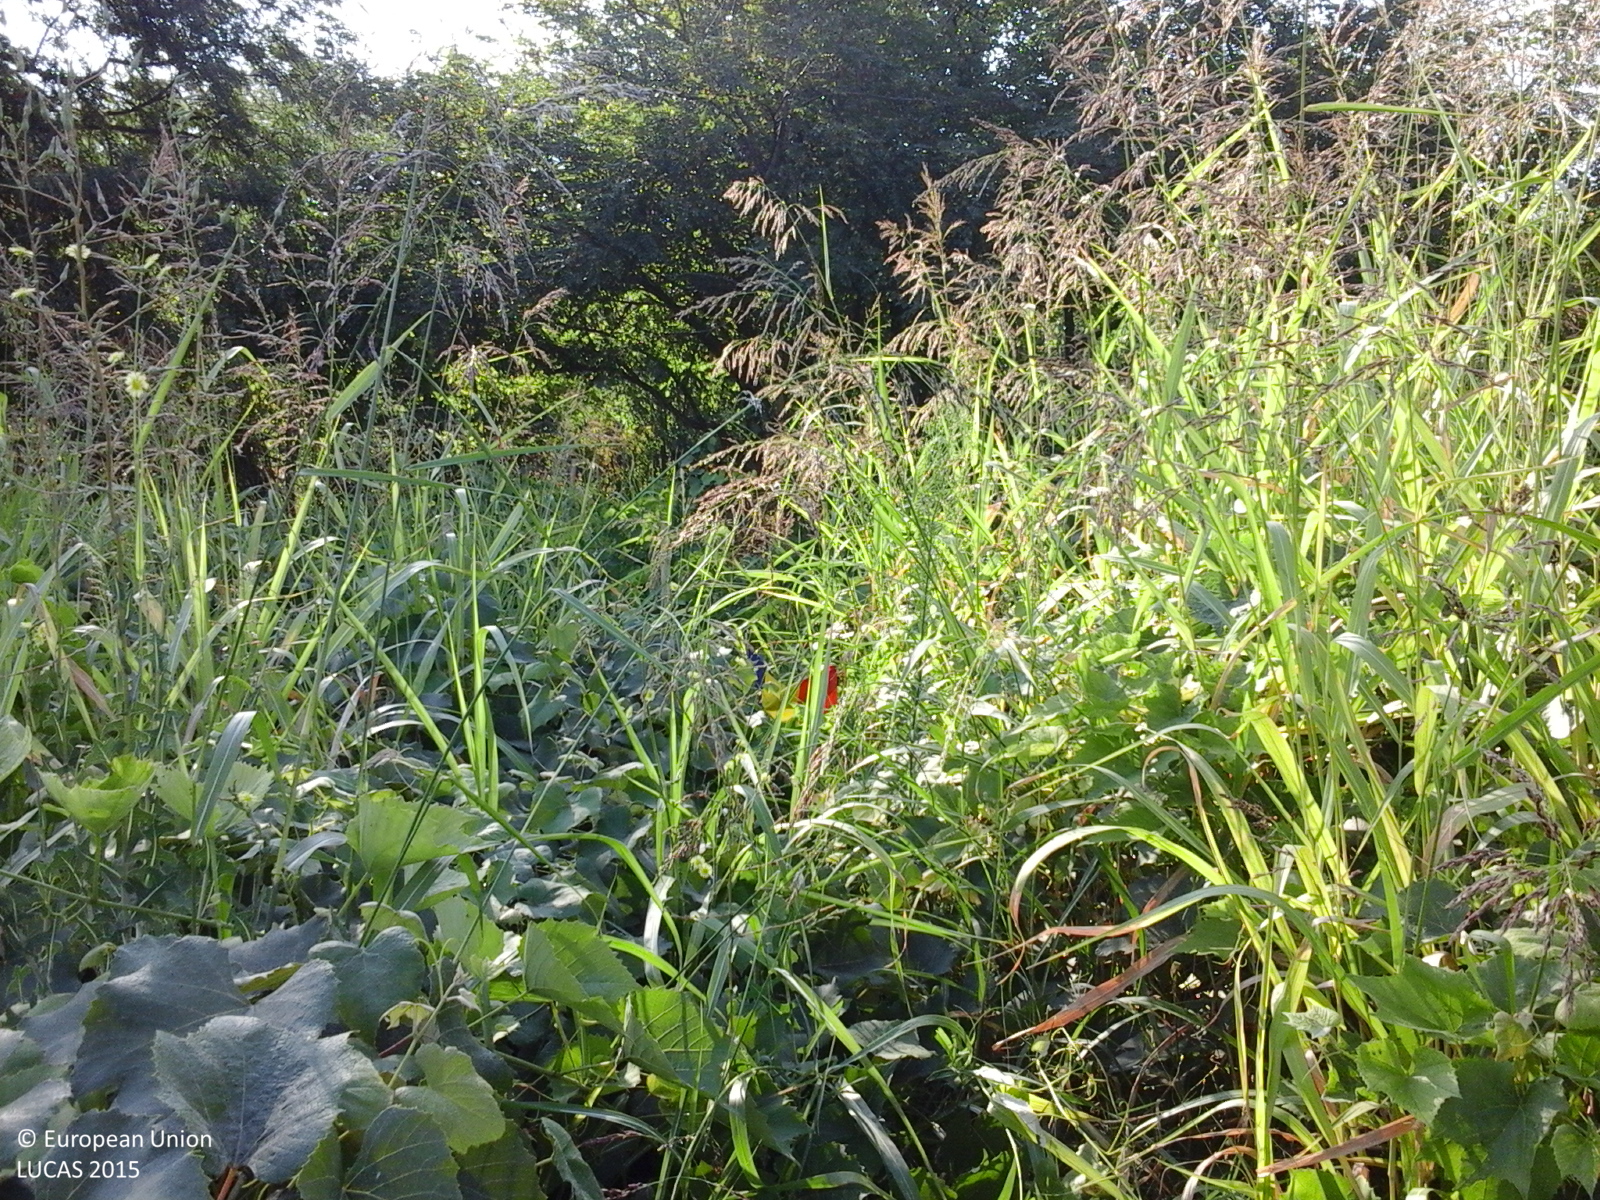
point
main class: Cropland
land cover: Vineyards
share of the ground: 50 - 75 %
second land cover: Grassland without tree/shrub cover
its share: > 75 %
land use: Agriculture (excluding fallow land and kitchen gardens)
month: August
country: RO
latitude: 44.0928
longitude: 23.2990
